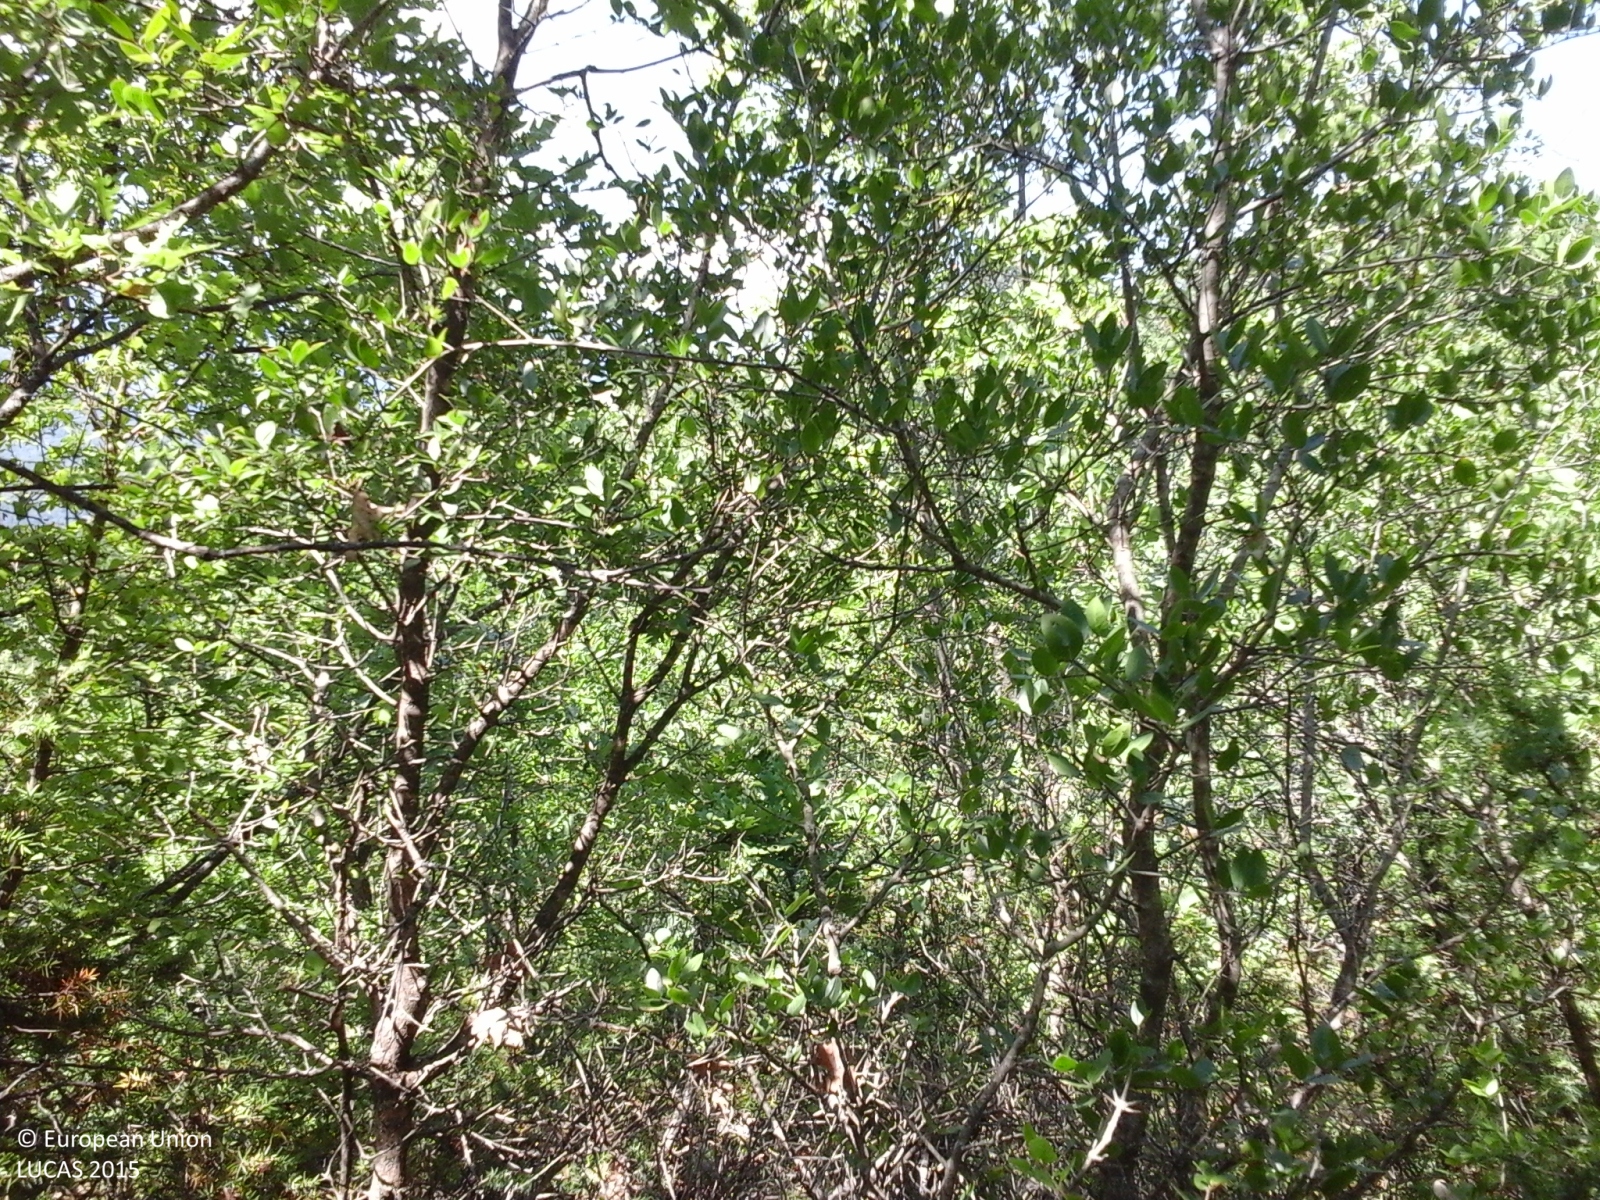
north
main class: Woodland
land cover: Broadleaved woodland
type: thermophilous deciduous forest
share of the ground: > 75 %
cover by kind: broadleaved forest trees 85 %, herbaceous plants 10 %, shrubs 5 %
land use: Forestry
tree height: > 5 m
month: July
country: GR
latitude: 40.0956
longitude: 20.7383
